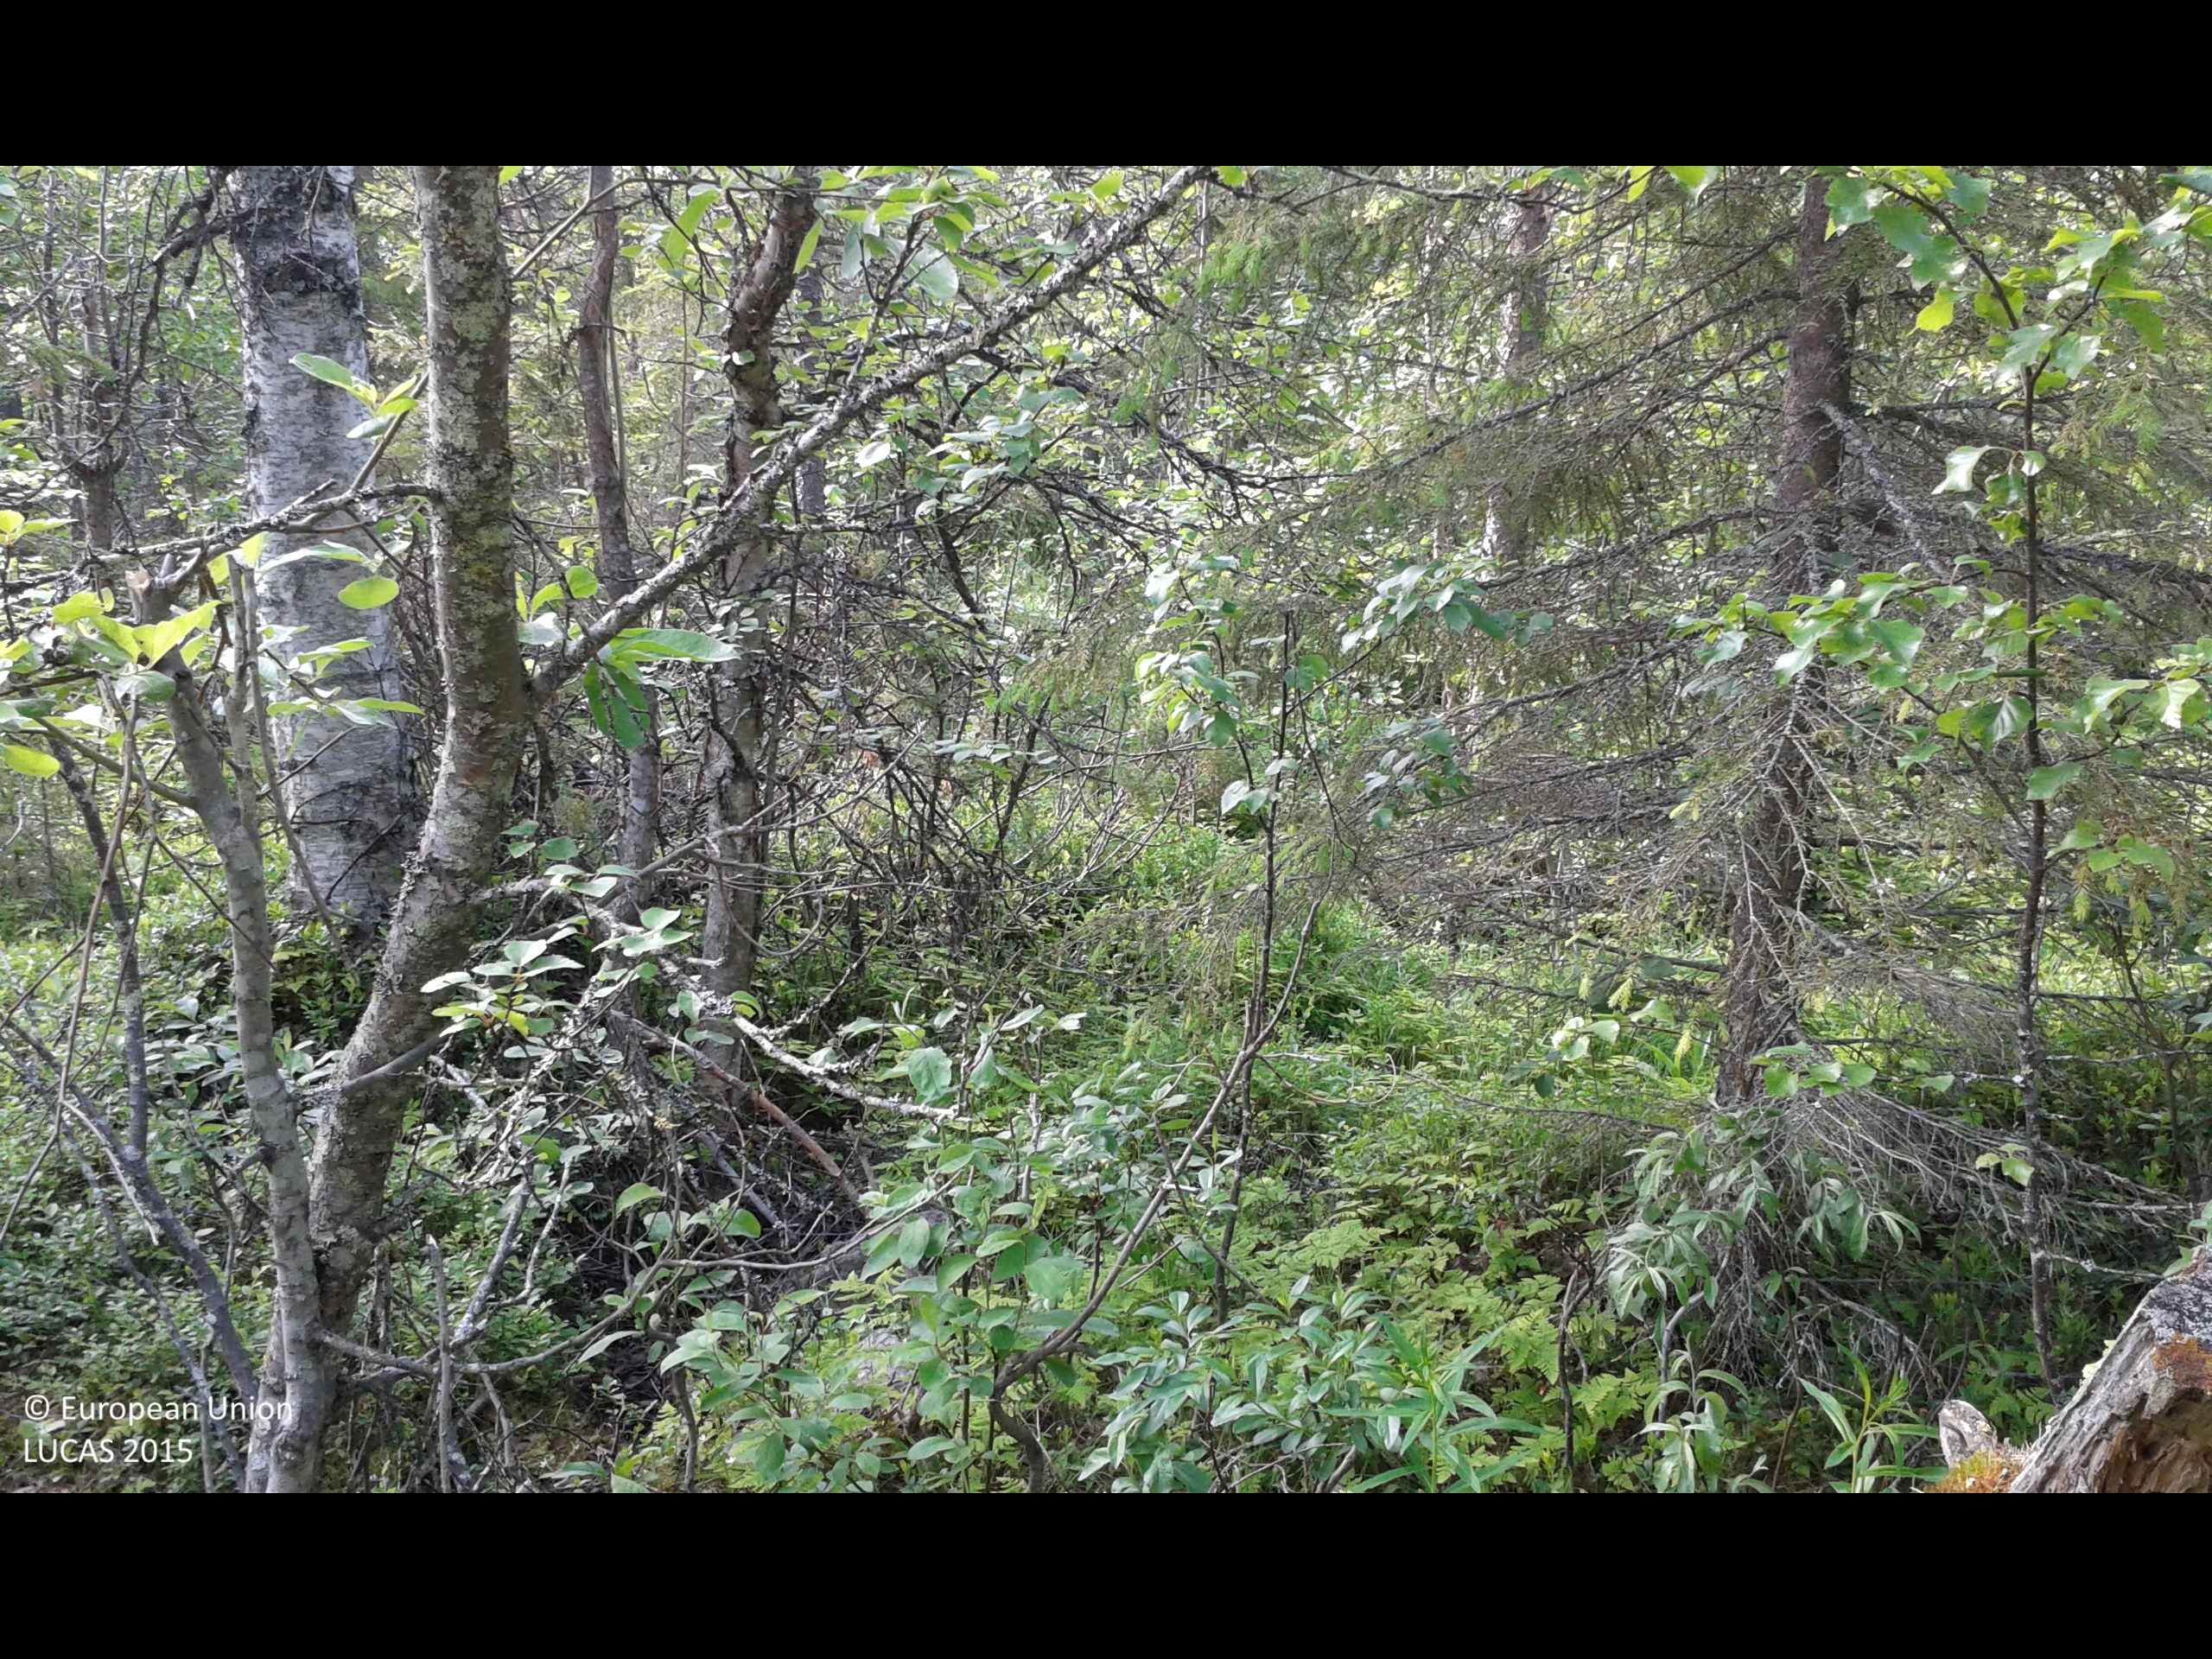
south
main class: Woodland
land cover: Pine dominated mixed woodland
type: boreal forest
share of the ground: 25 - 50 %
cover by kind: shrubs 50 %, coniferous forest trees 20 %, herbaceous plants 15 %, broadleaved forest trees 10 %, lichens and mosses 5 %
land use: Forestry
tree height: > 5 m
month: July
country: SE
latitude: 66.7492
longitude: 23.4413
